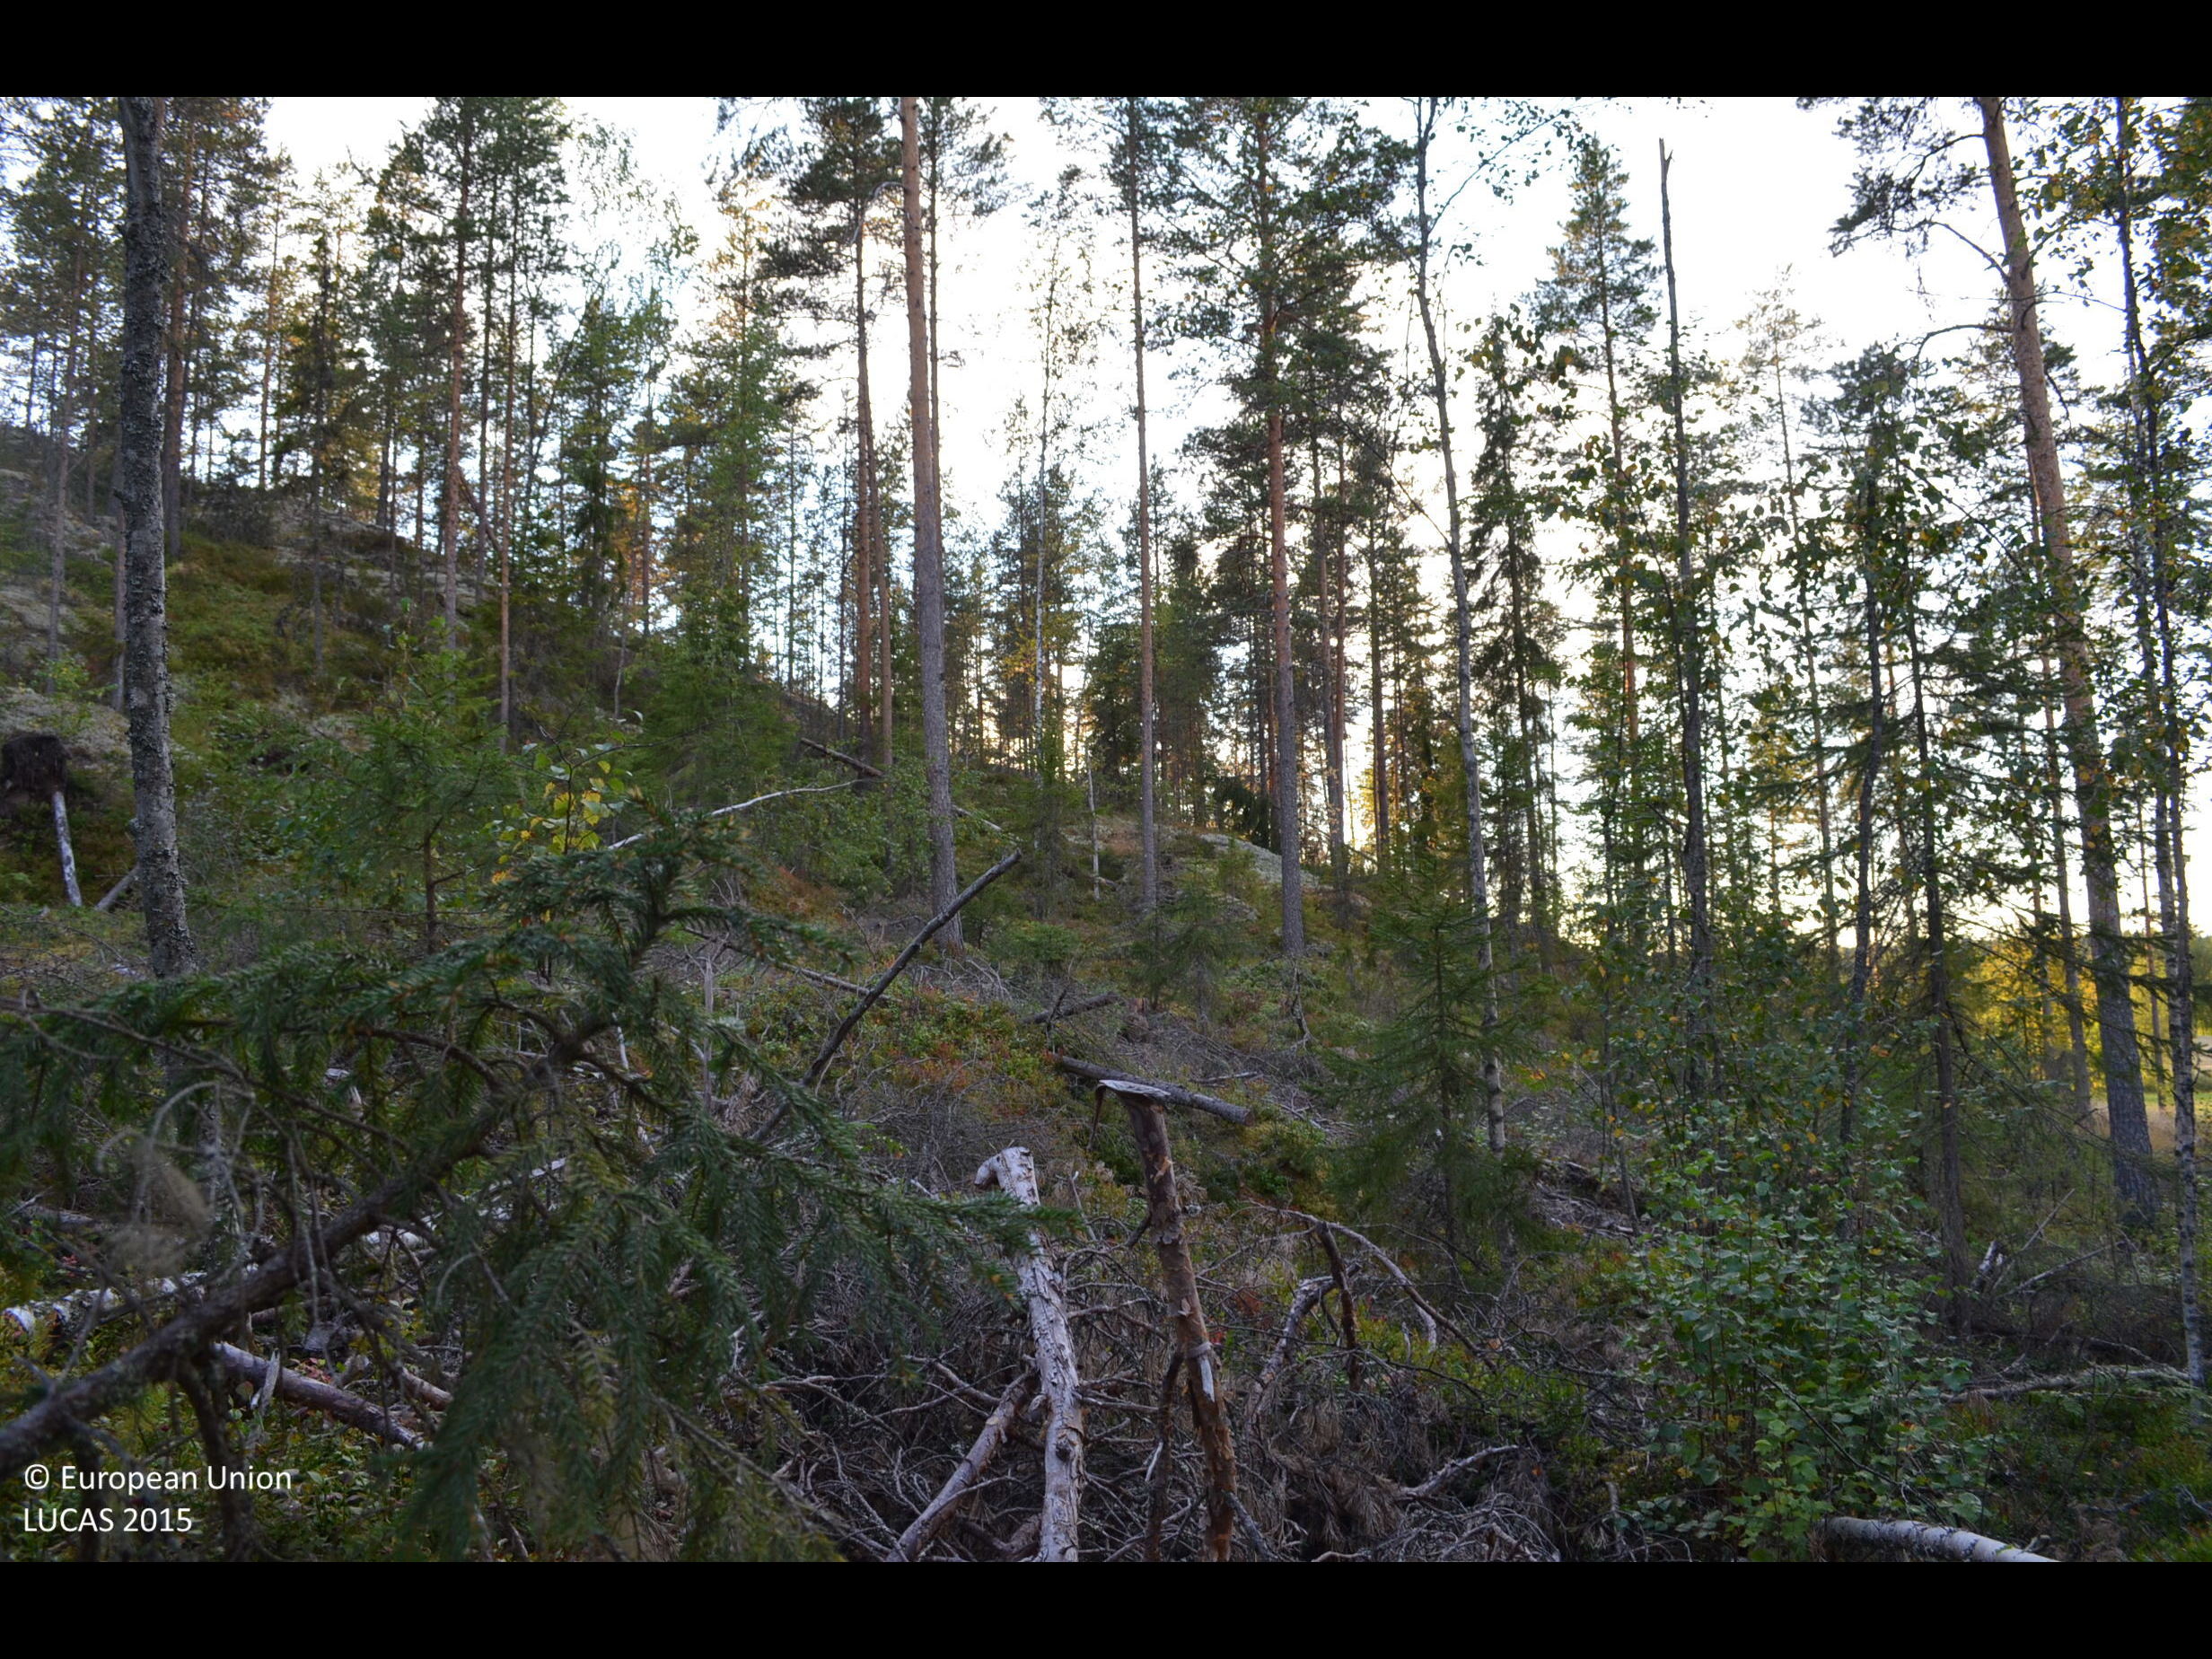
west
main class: Woodland
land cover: Other coniferous woodland
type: boreal forest
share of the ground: 50 - 75 %
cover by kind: coniferous forest trees 50 %, shrubs 30 %, broadleaved forest trees 10 %
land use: Forestry
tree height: > 5 m
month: August
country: FI
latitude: 62.4097
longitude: 23.6415
